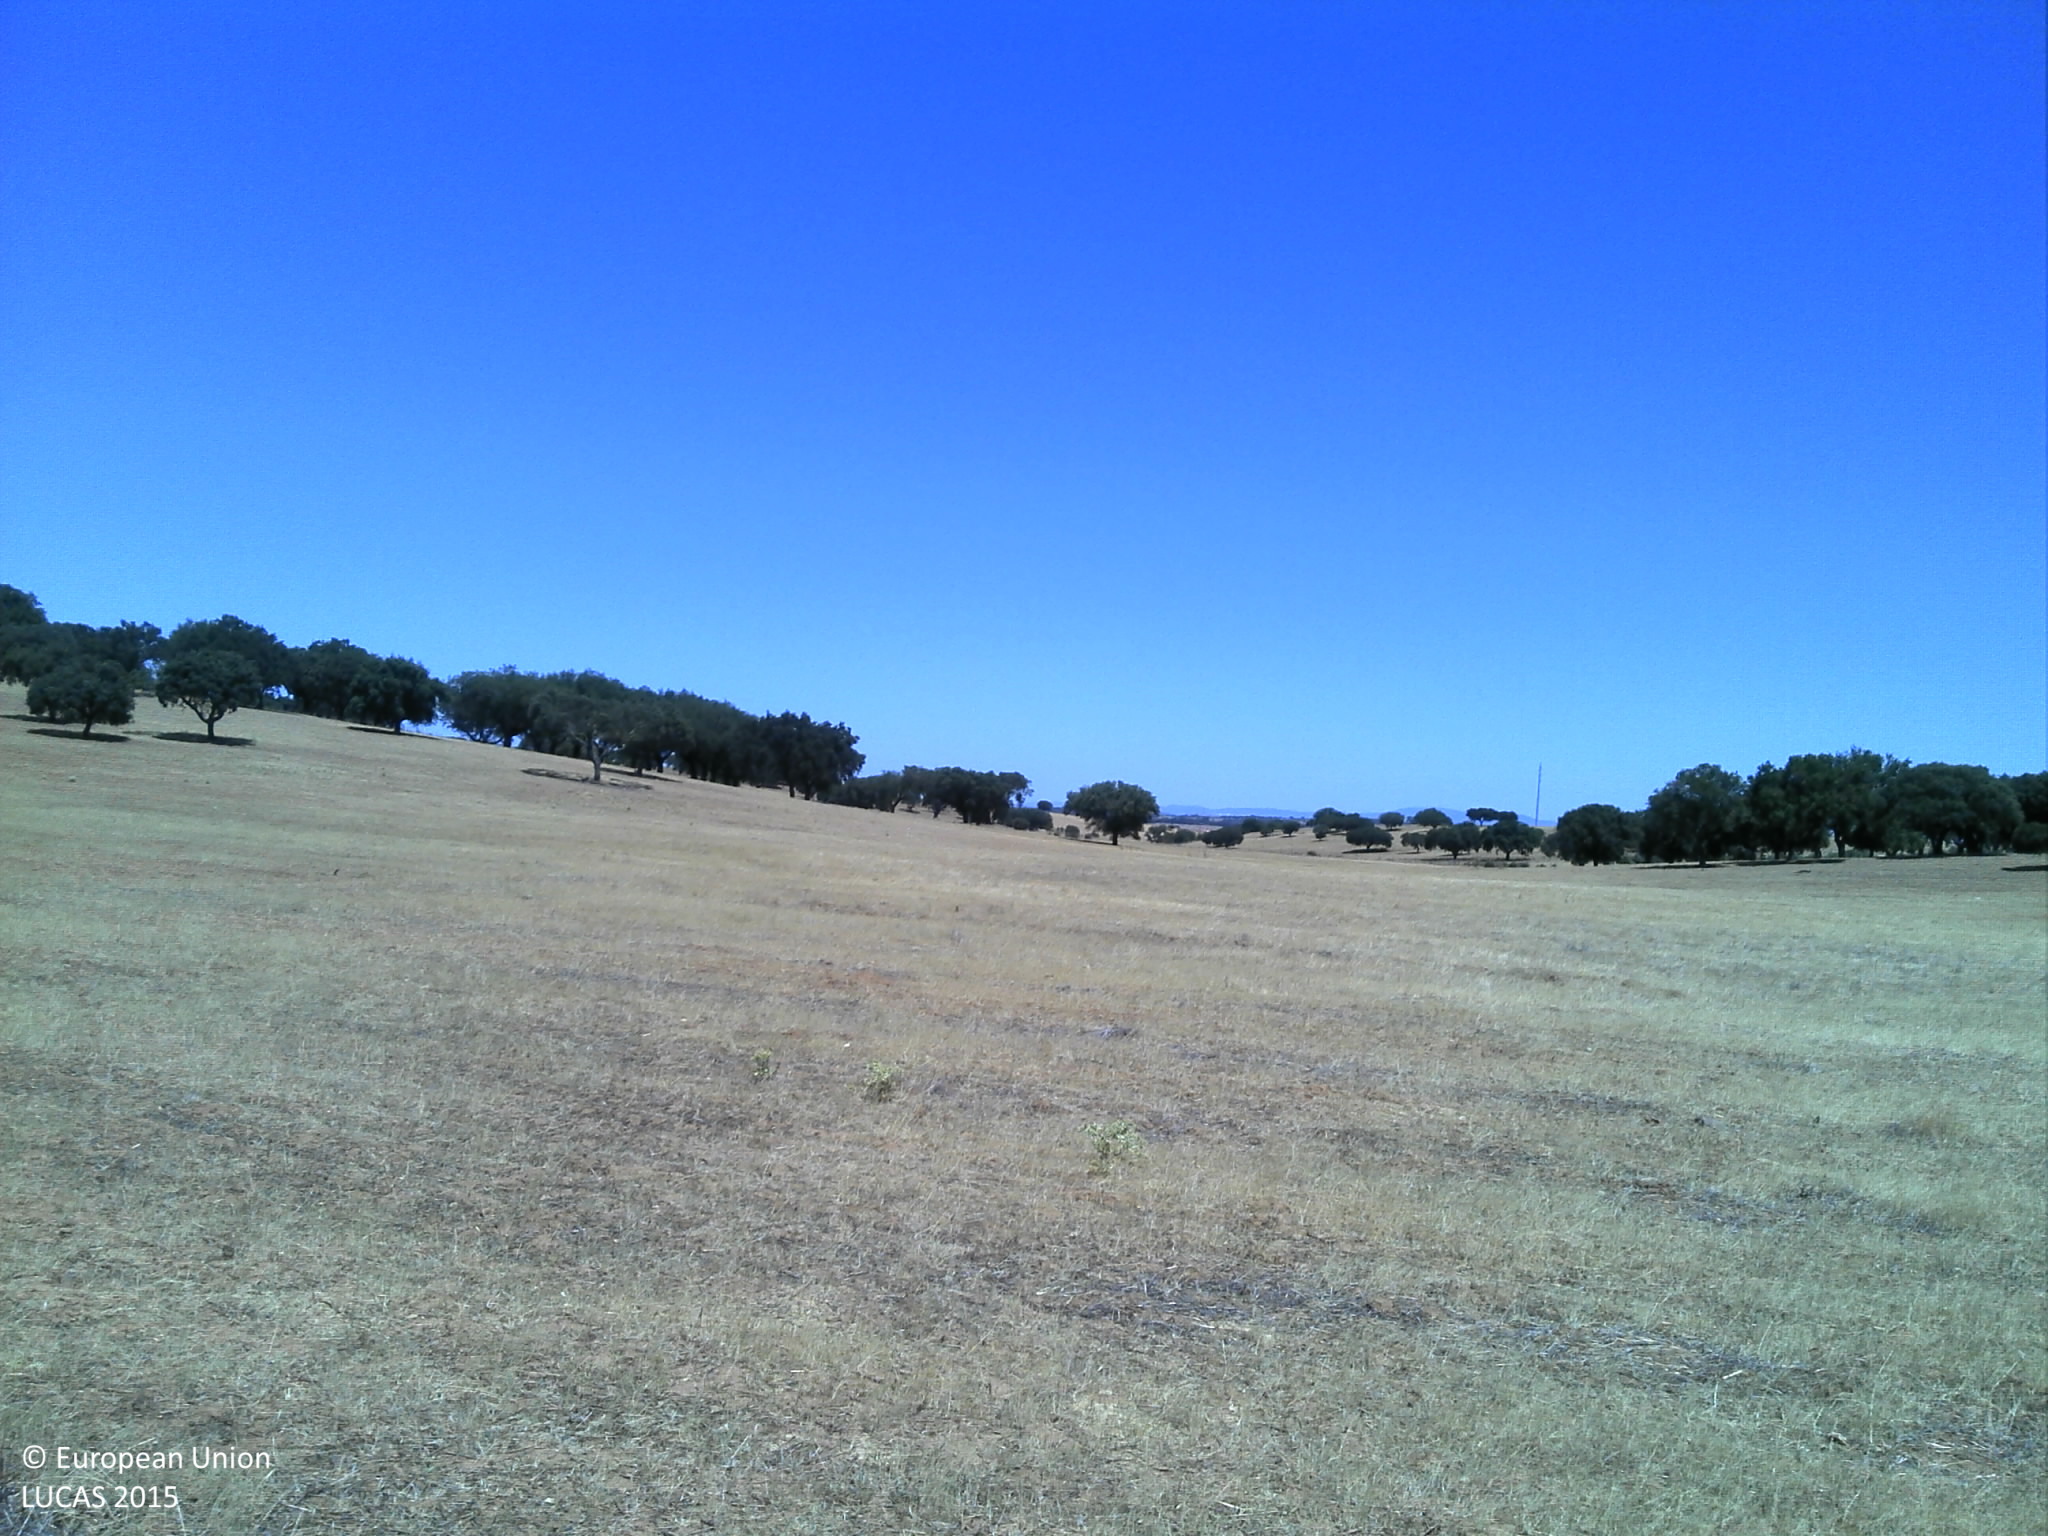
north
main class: Grassland
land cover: Grassland without tree/shrub cover
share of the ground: 10 - 25 %
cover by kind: unconsolidated bare surface 80 %, herbaceous plants 20 %
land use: Agriculture (excluding fallow land and kitchen gardens)
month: July
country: PT
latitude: 38.8836
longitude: -7.5003
